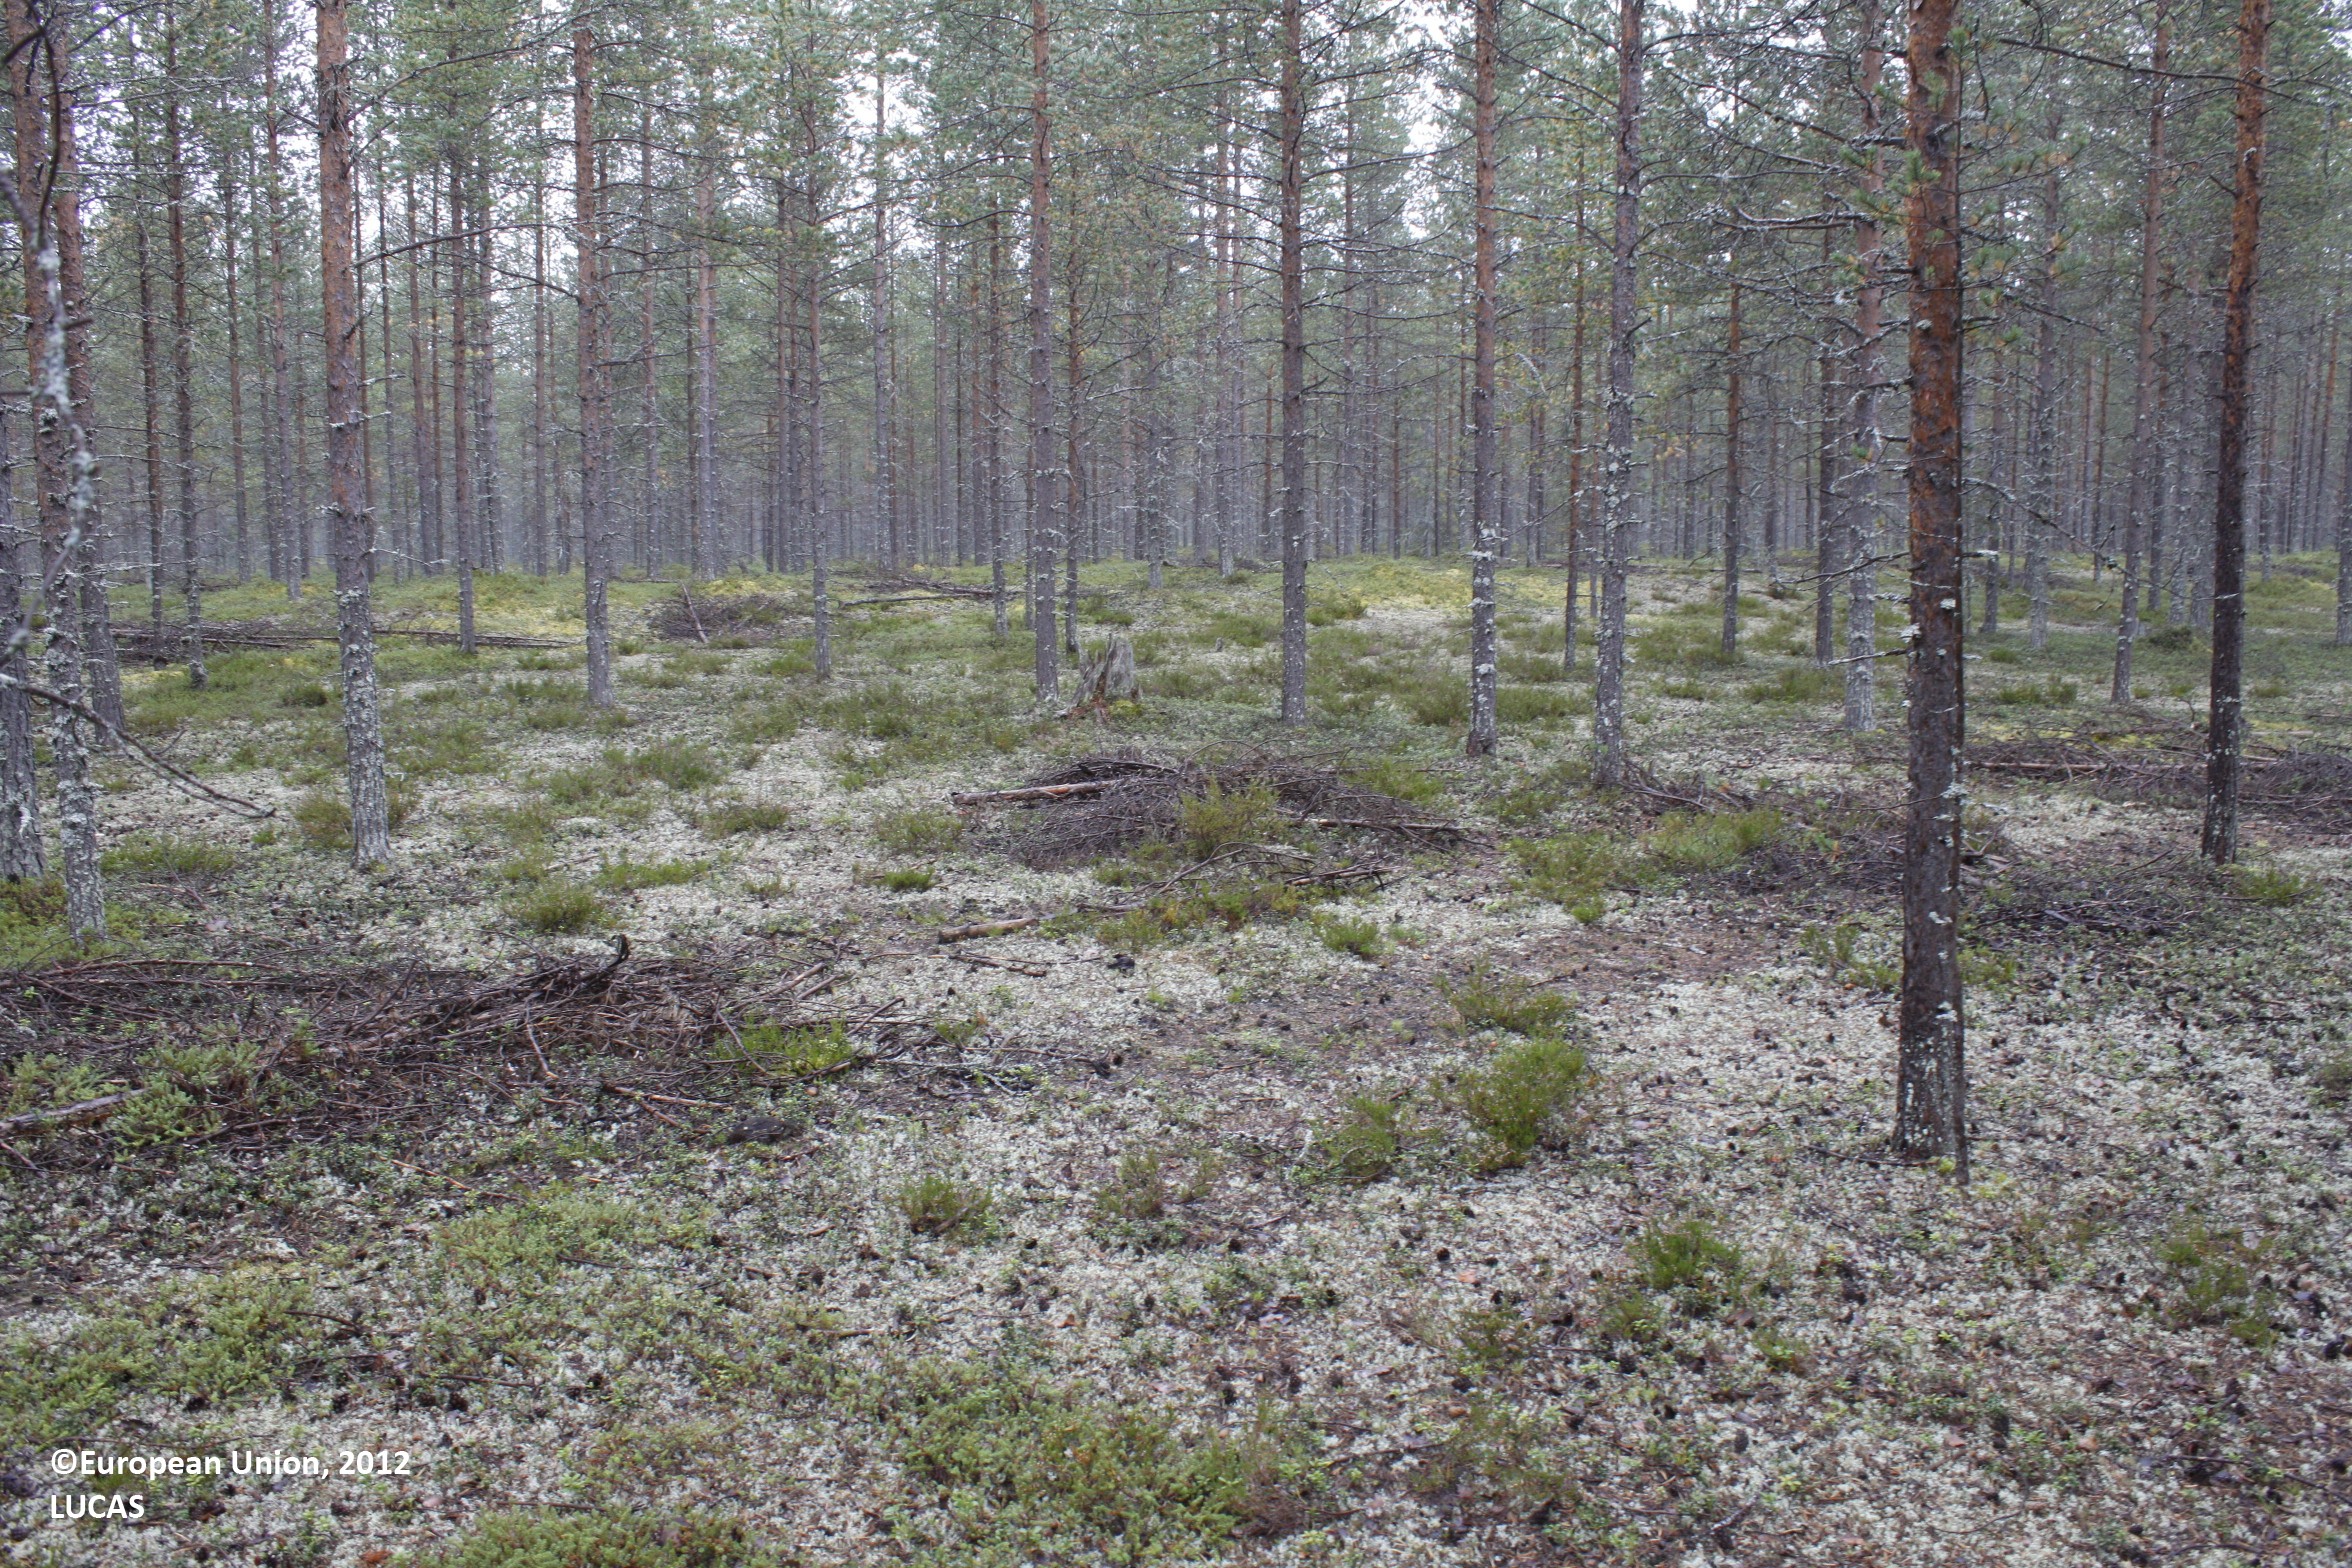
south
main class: Woodland
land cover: Pine dominated coniferous woodland
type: mire and swamp forests
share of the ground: 25 - 50 %
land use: Forestry
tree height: > 5 m
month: September
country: FI
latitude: 65.3928
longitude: 26.9237
